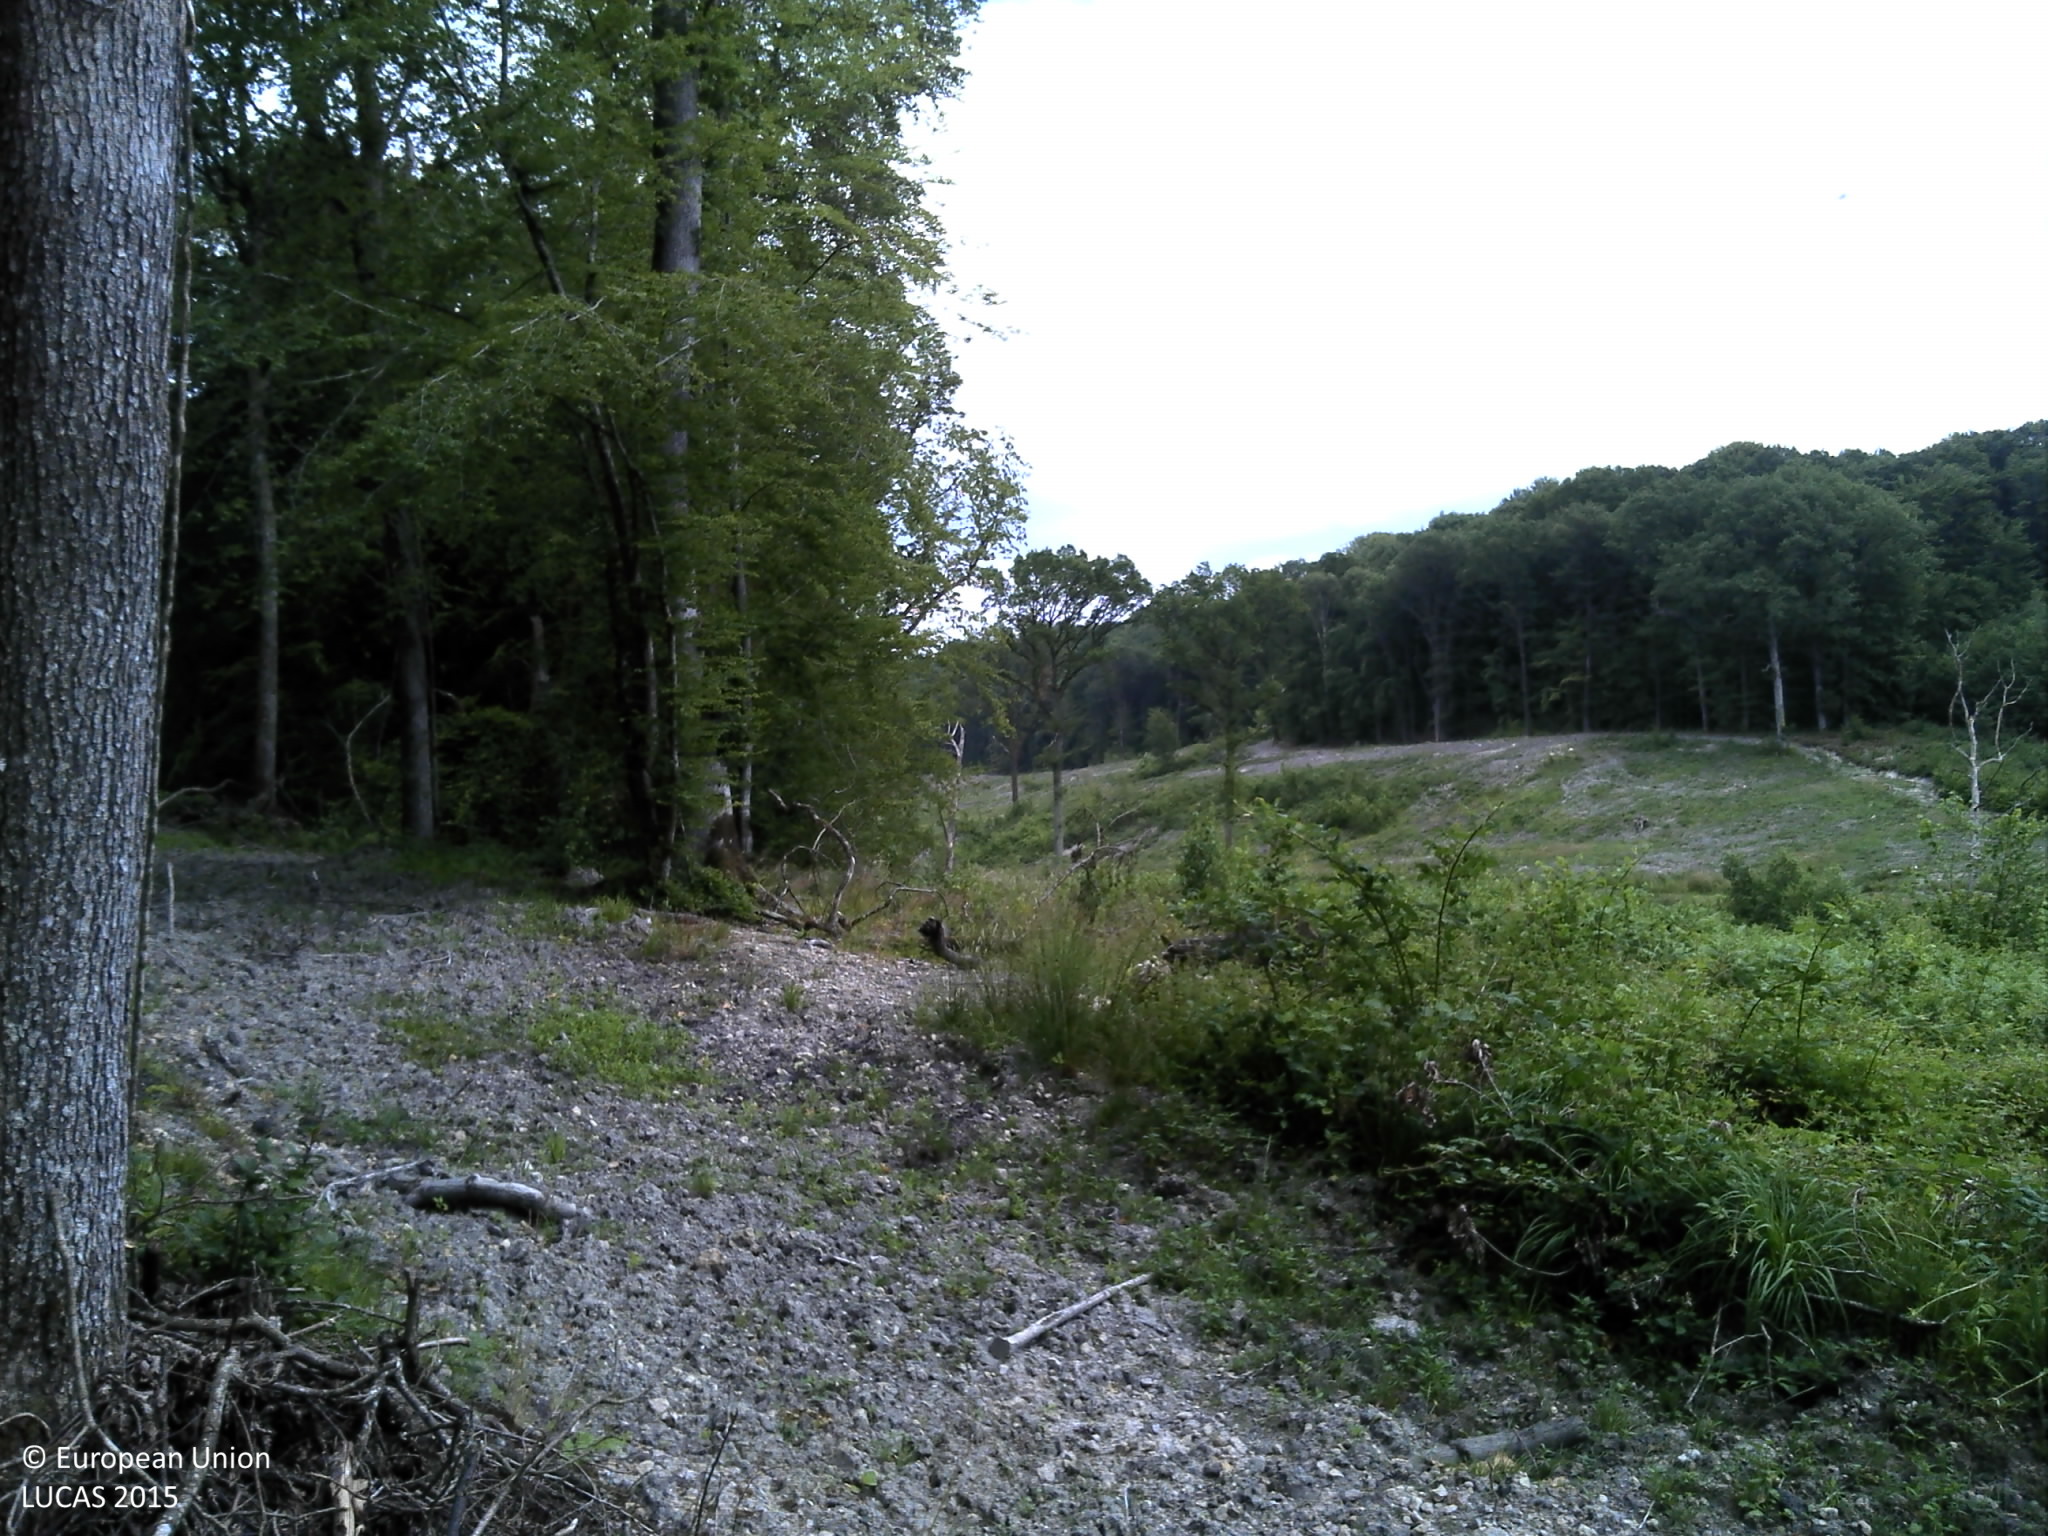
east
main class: Woodland
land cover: Broadleaved woodland
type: acidophilous oak and oak-birch forest
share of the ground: > 75 %
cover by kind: broadleaved forest trees 55 %, herbaceous plants 40 %, lichens and mosses 5 %
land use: Forestry
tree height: < 5 m
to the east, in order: Shrubland without tree cover; Spontaneously vegetated surfaces; Broadleaved woodland; Rivers and streams; Spontaneously vegetated surfaces
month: June
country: FR
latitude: 49.3835
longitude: 4.8591
